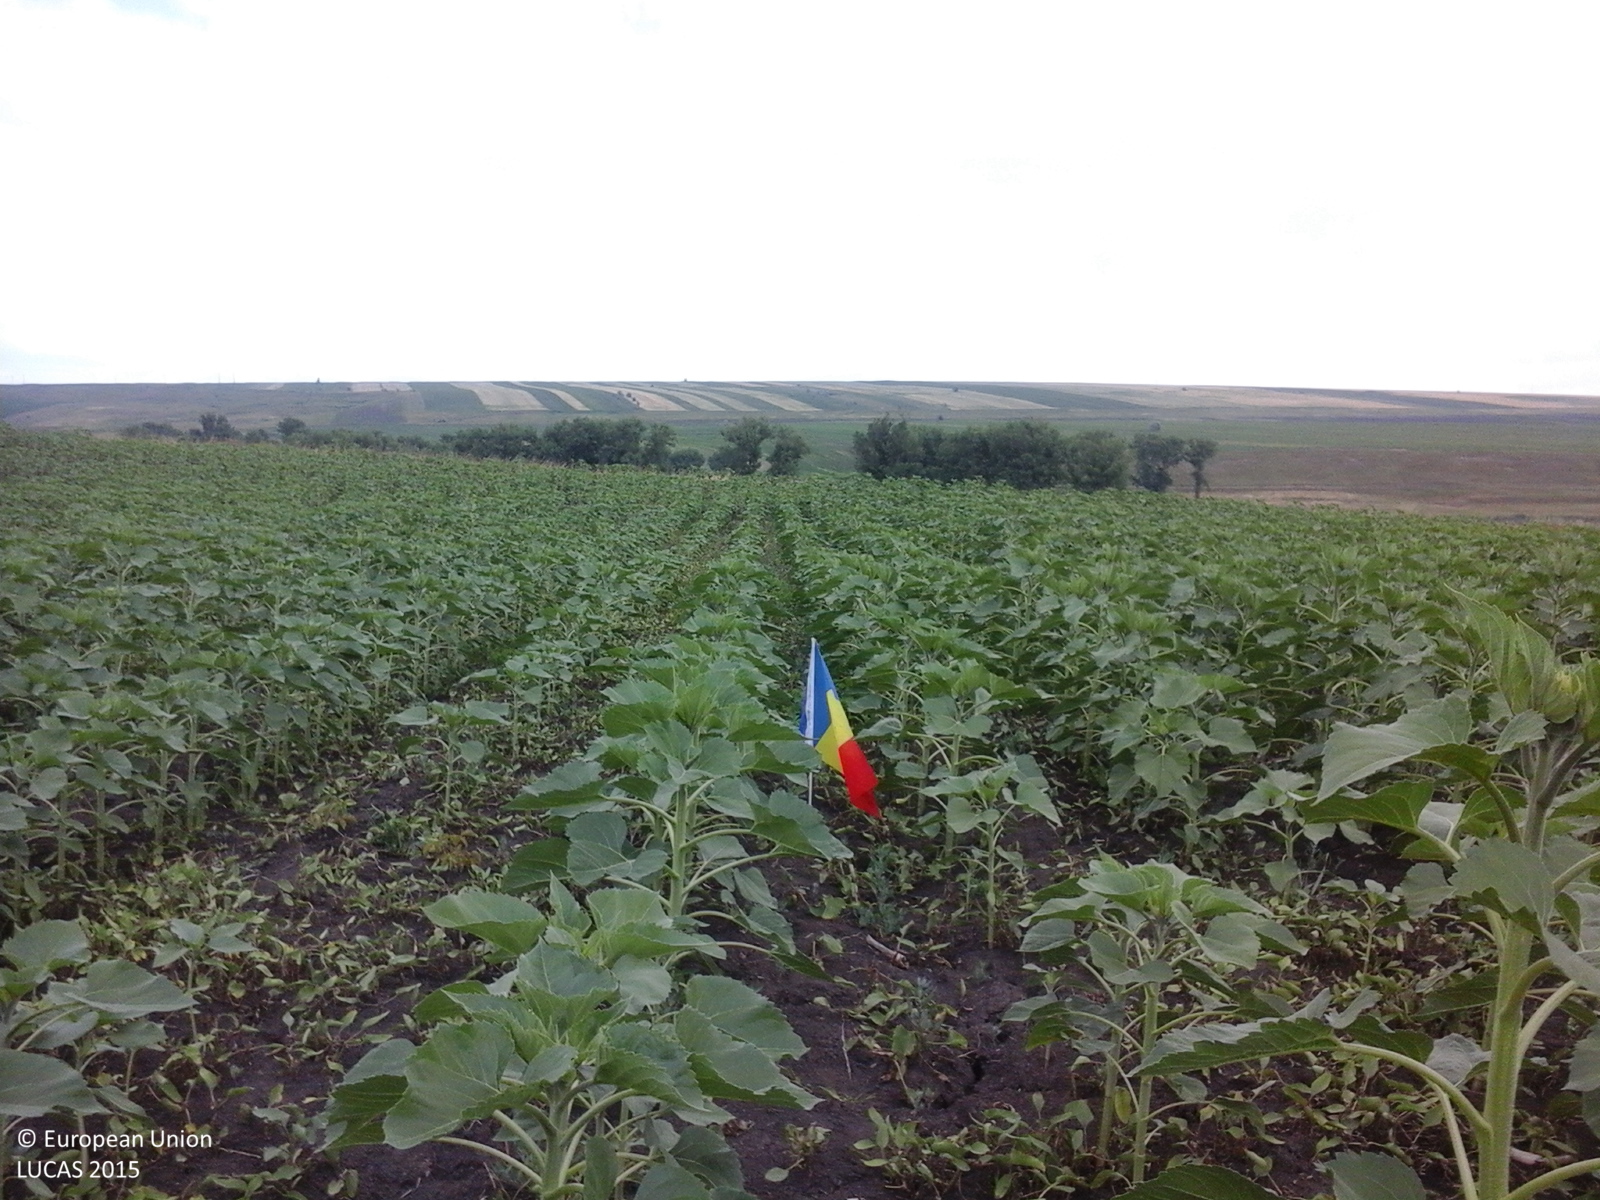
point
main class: Cropland
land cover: Sunflower
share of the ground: 25 - 50 %
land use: Agriculture (excluding fallow land and kitchen gardens)
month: June
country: RO
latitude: 48.0200
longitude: 26.7103
